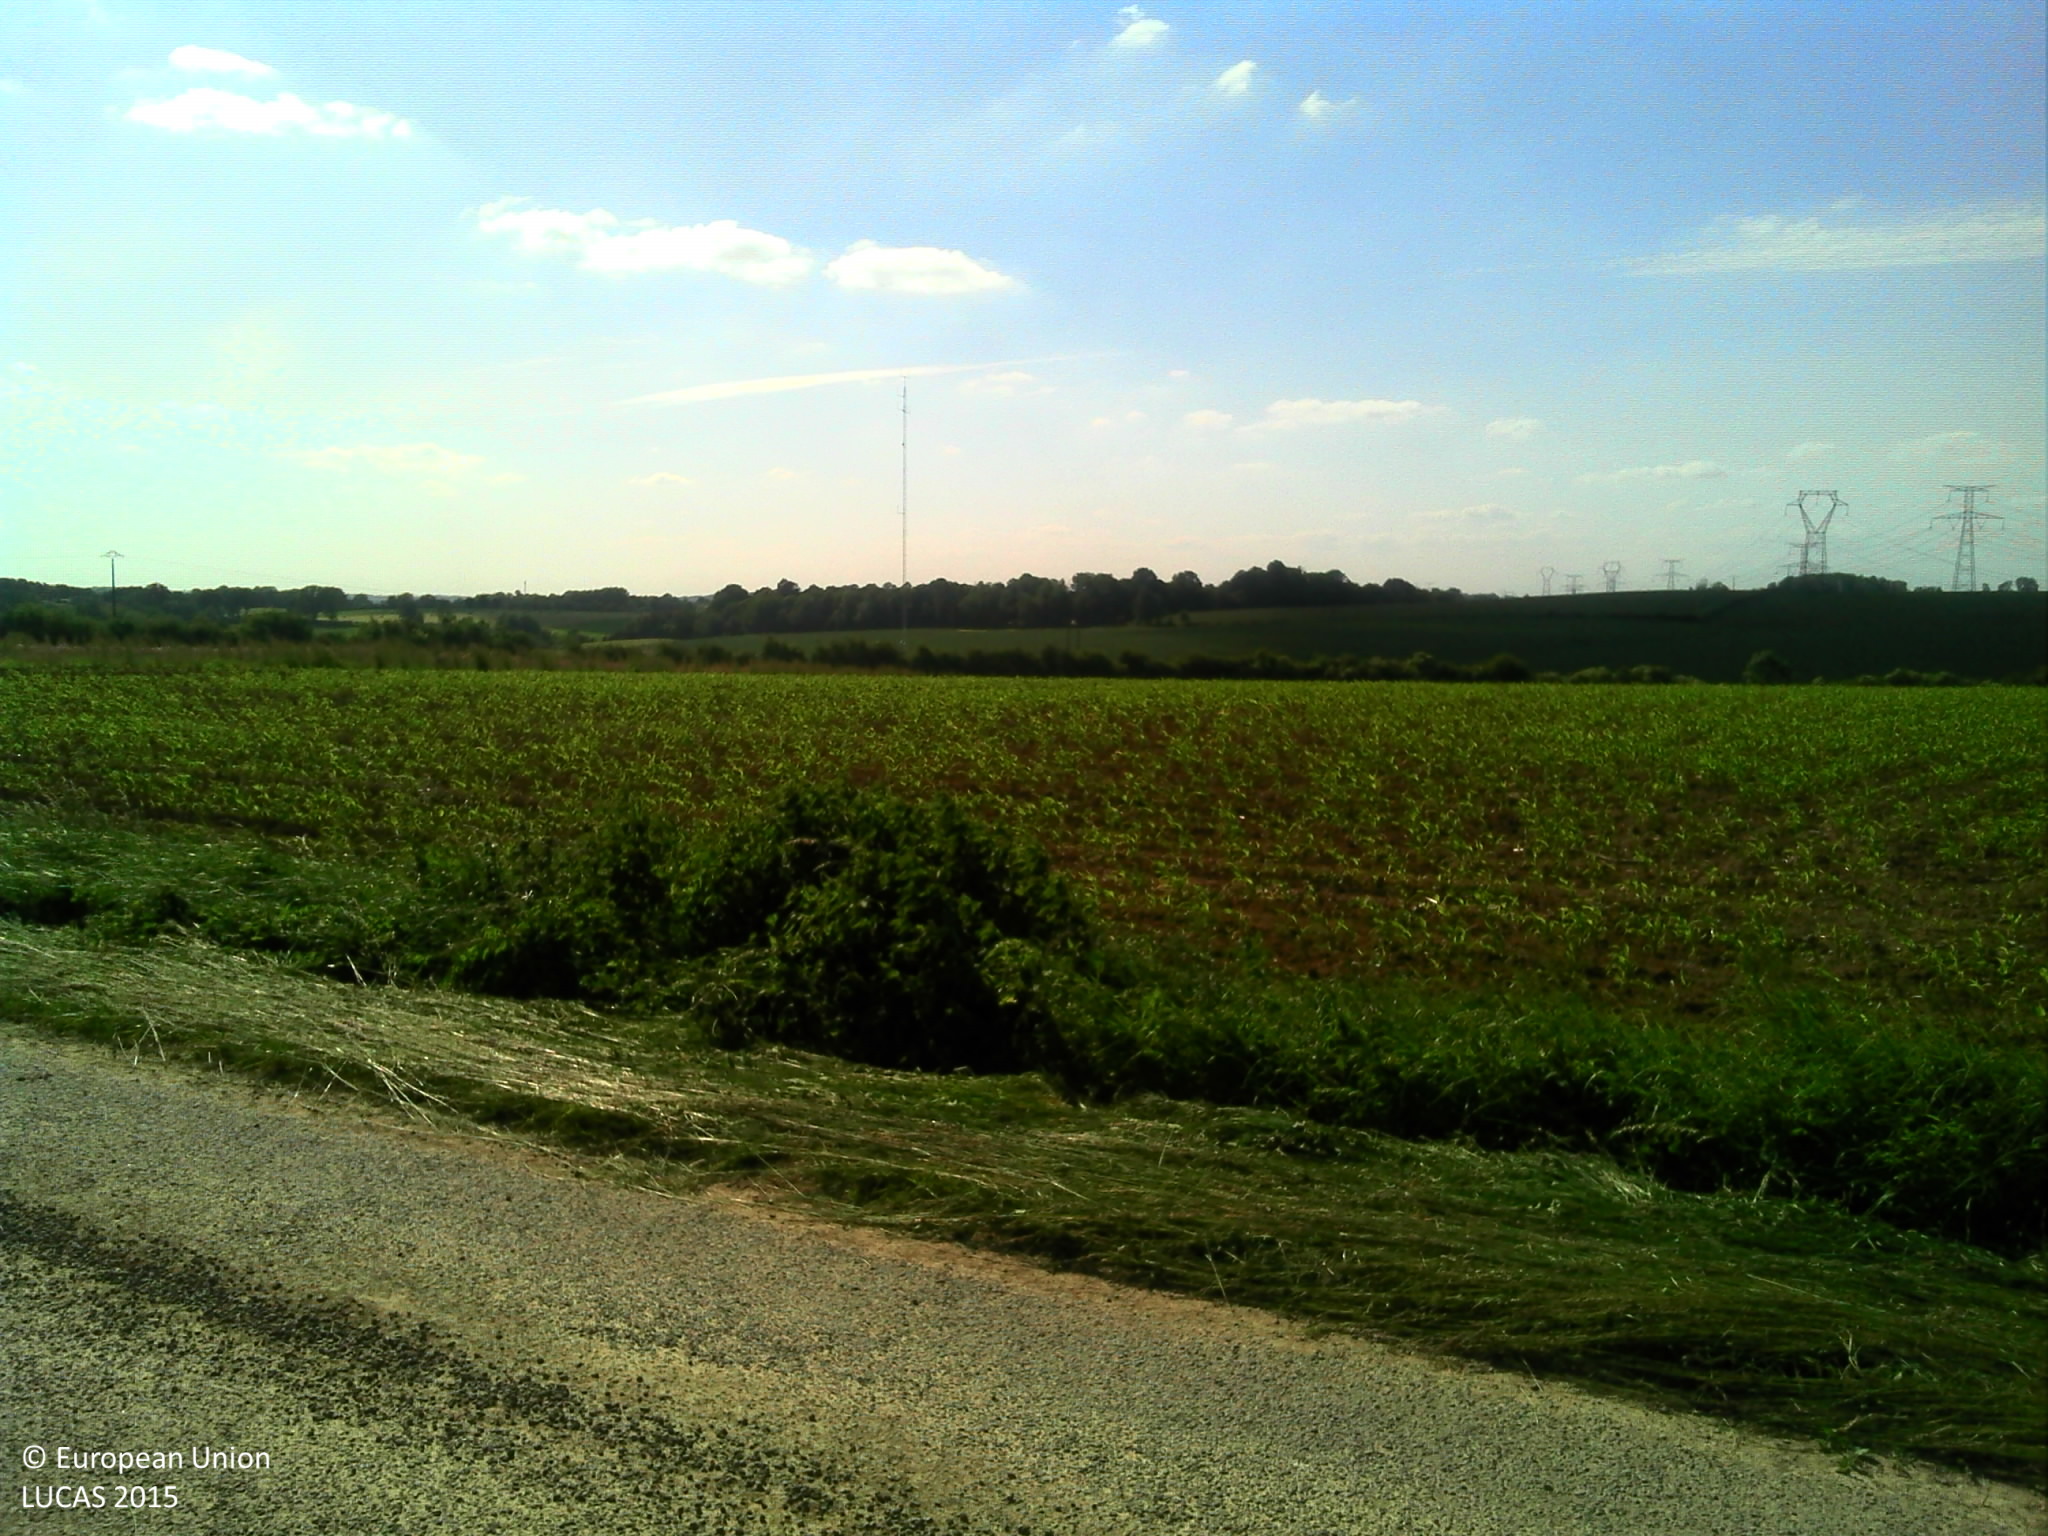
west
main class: Grassland
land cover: Grassland without tree/shrub cover
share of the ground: > 75 %
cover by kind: herbaceous plants 100 %
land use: Agriculture (excluding fallow land and kitchen gardens)
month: June
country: FR
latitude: 49.8862
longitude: 4.0795
